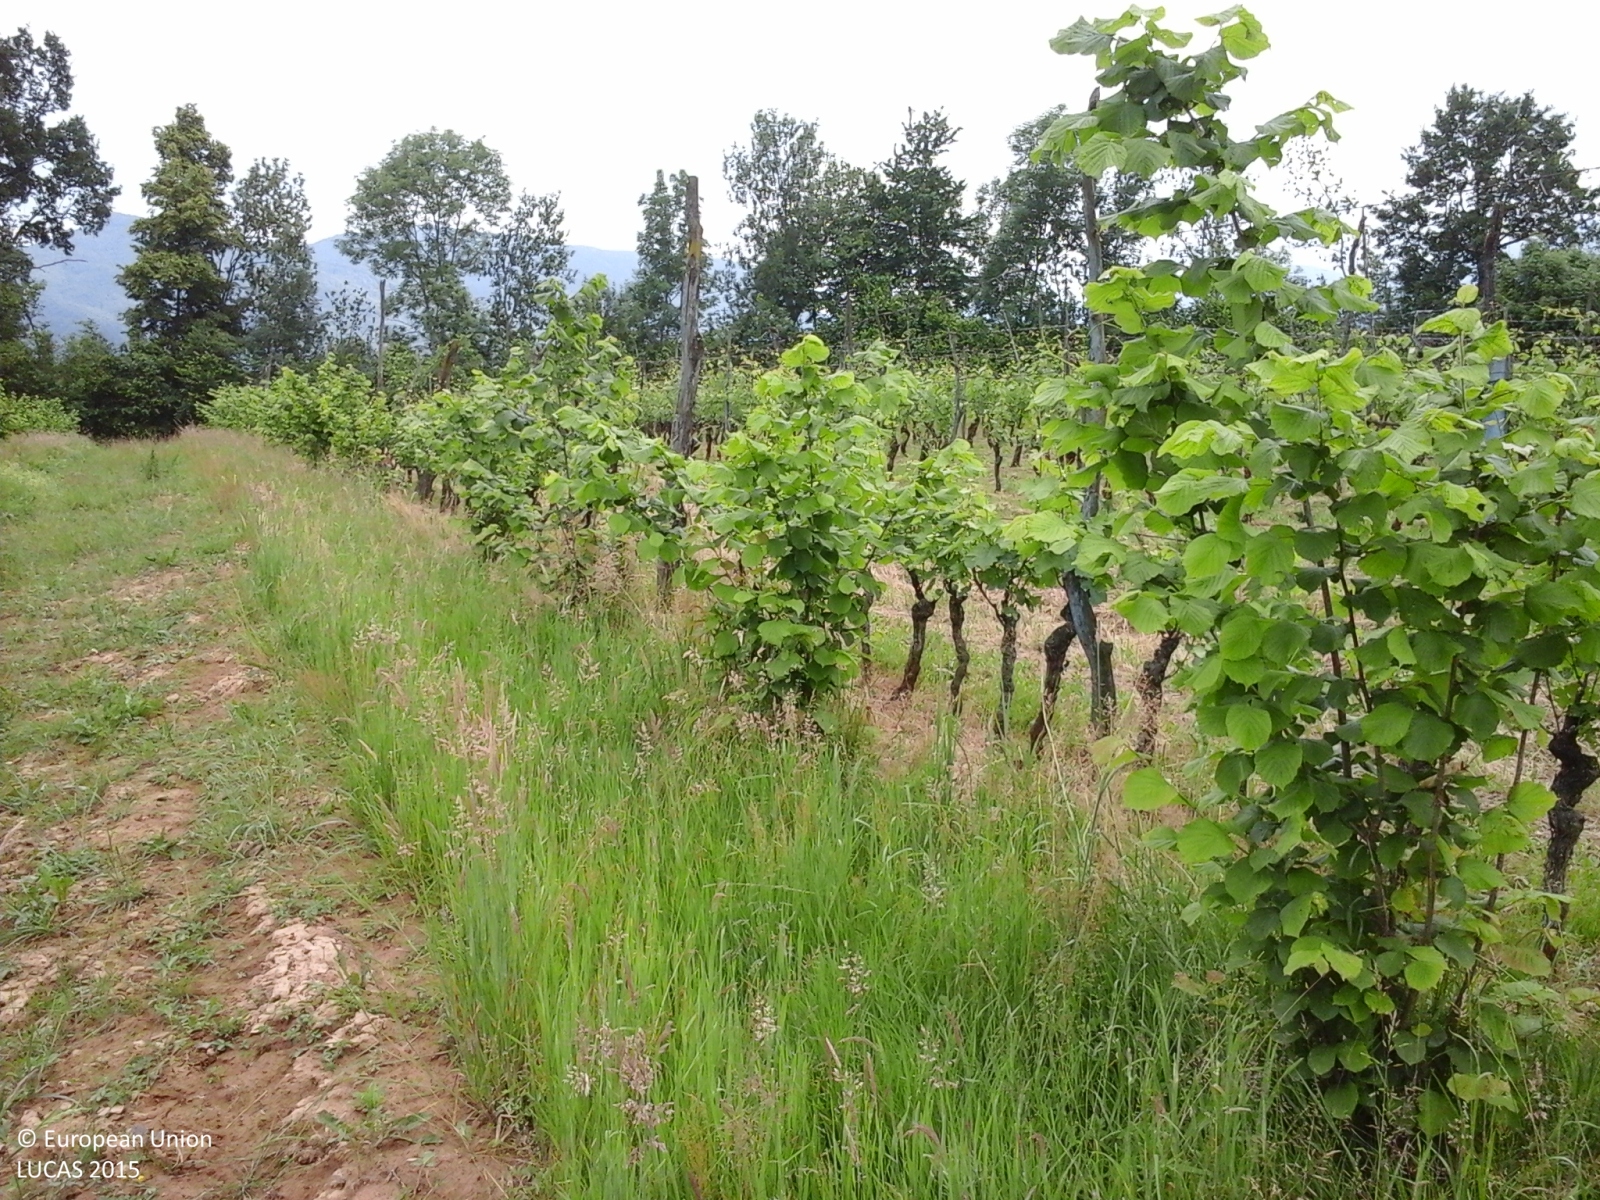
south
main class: Cropland
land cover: Nuts trees
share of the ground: 50 - 75 %
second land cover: Grassland without tree/shrub cover
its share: > 75 %
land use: Agriculture (excluding fallow land and kitchen gardens)
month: May
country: IT
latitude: 44.7489
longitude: 7.3146
